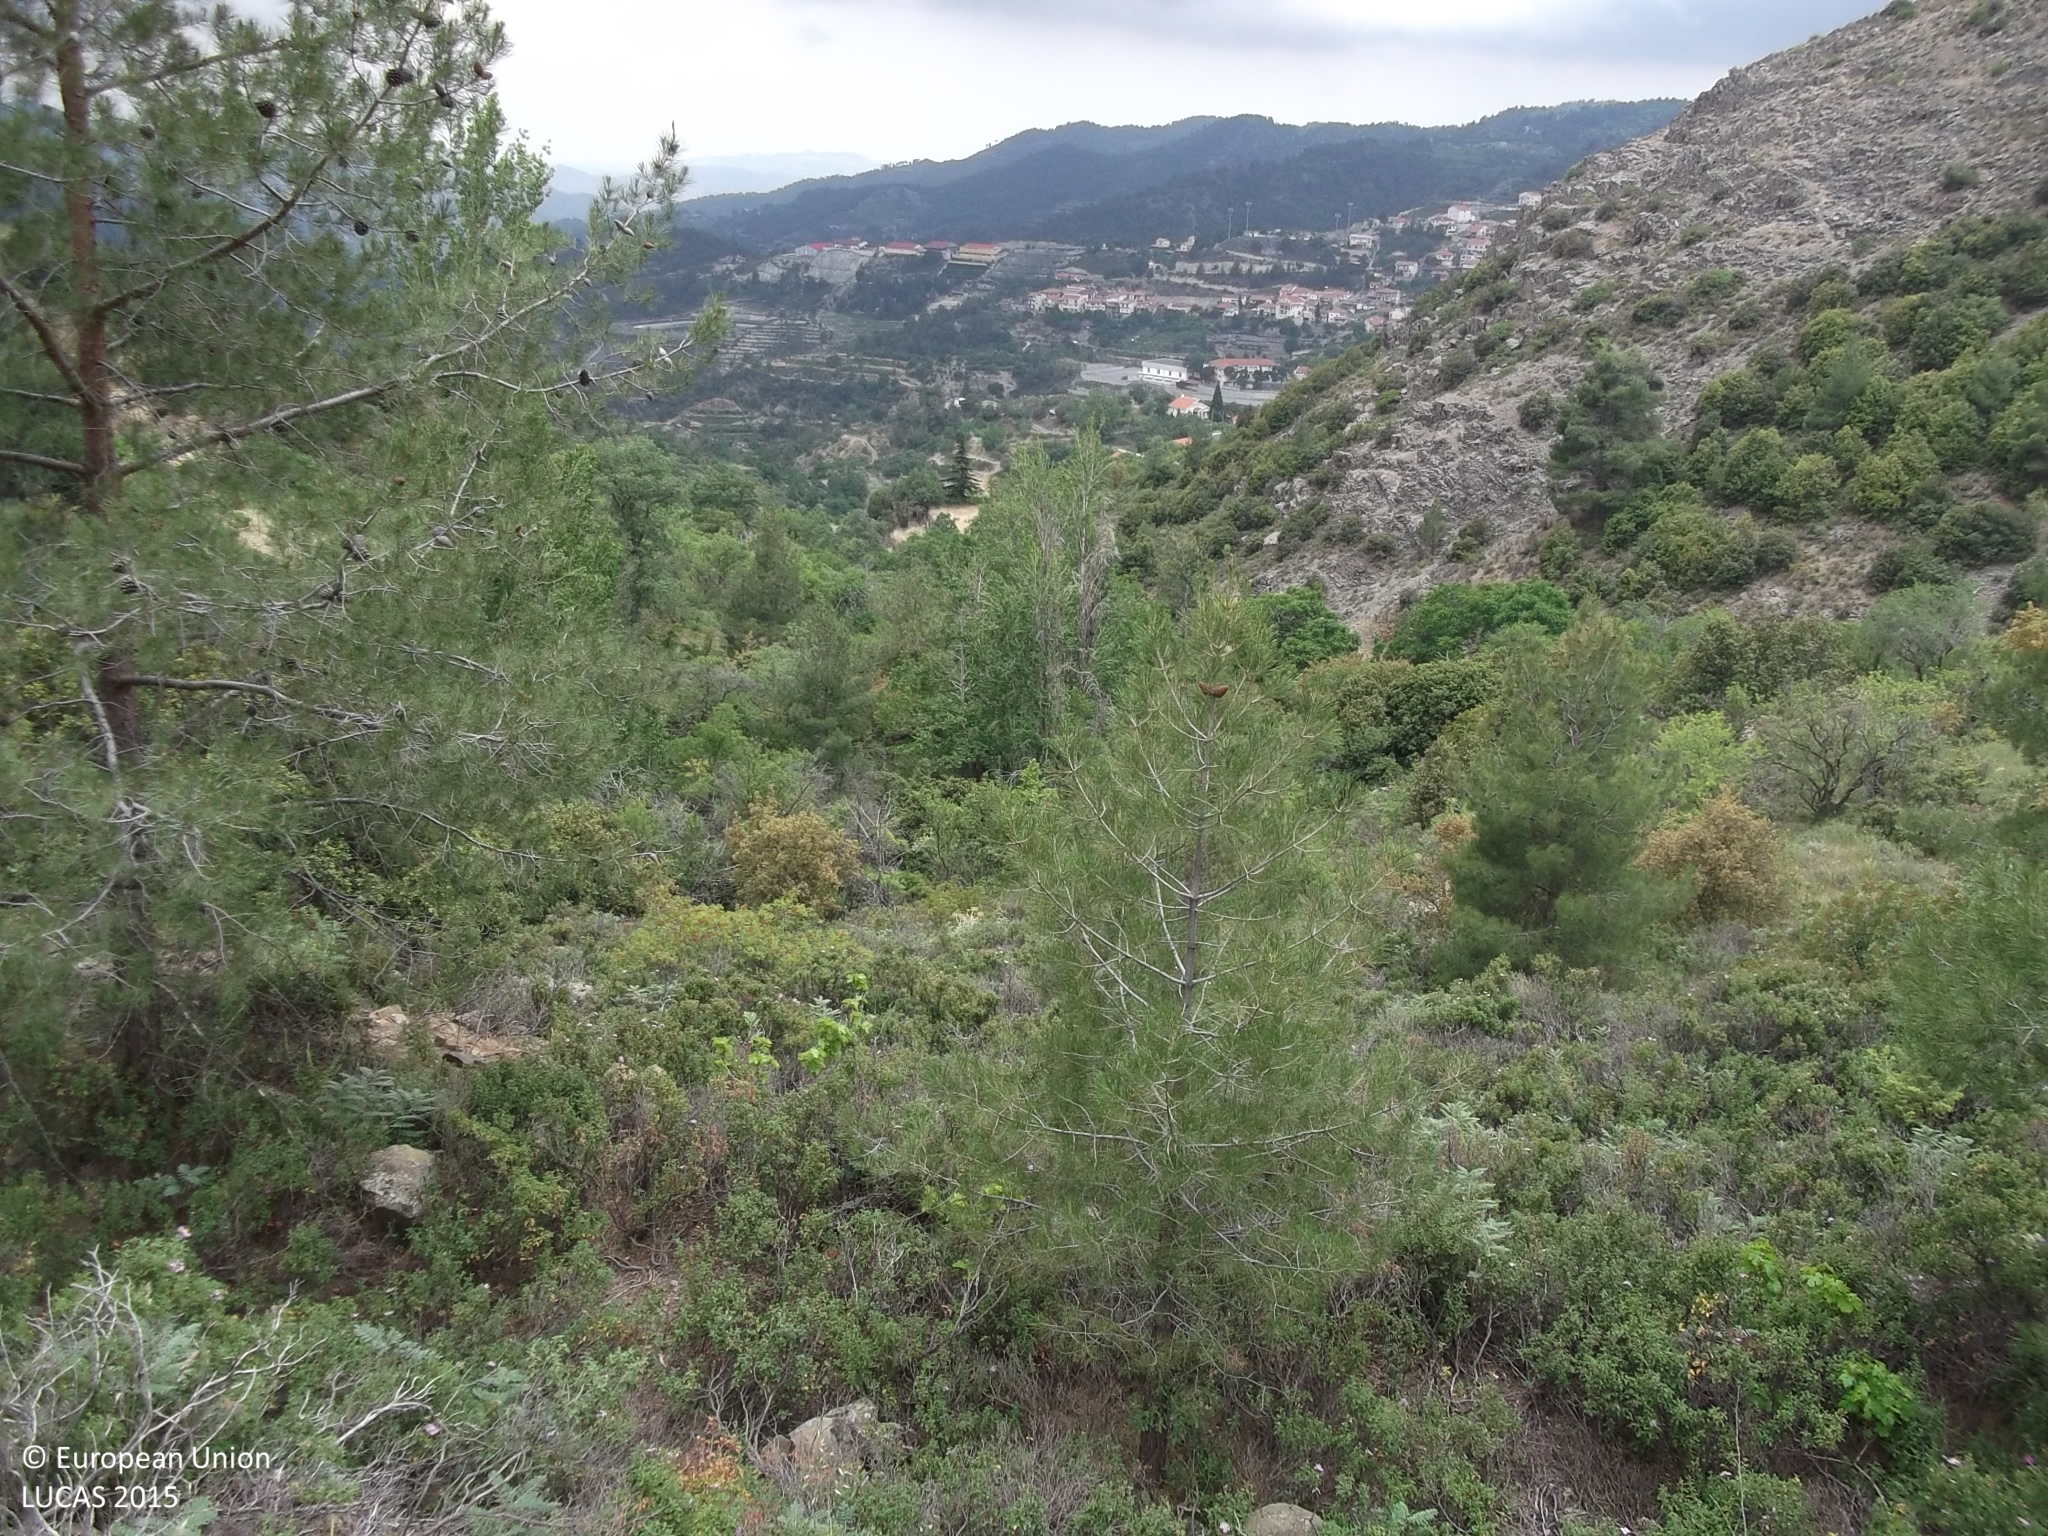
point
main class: Woodland
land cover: Pine dominated mixed woodland
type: coniferous forest of the mediterranean region
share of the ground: 25 - 50 %
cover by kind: coniferous forest trees 40 %, shrubs 35 %, broadleaved forest trees 15 %, unconsolidated bare surface 10 %
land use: Semi-natural and natural areas not in use
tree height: > 5 m
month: June
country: CY
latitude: 34.9490
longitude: 32.9802
